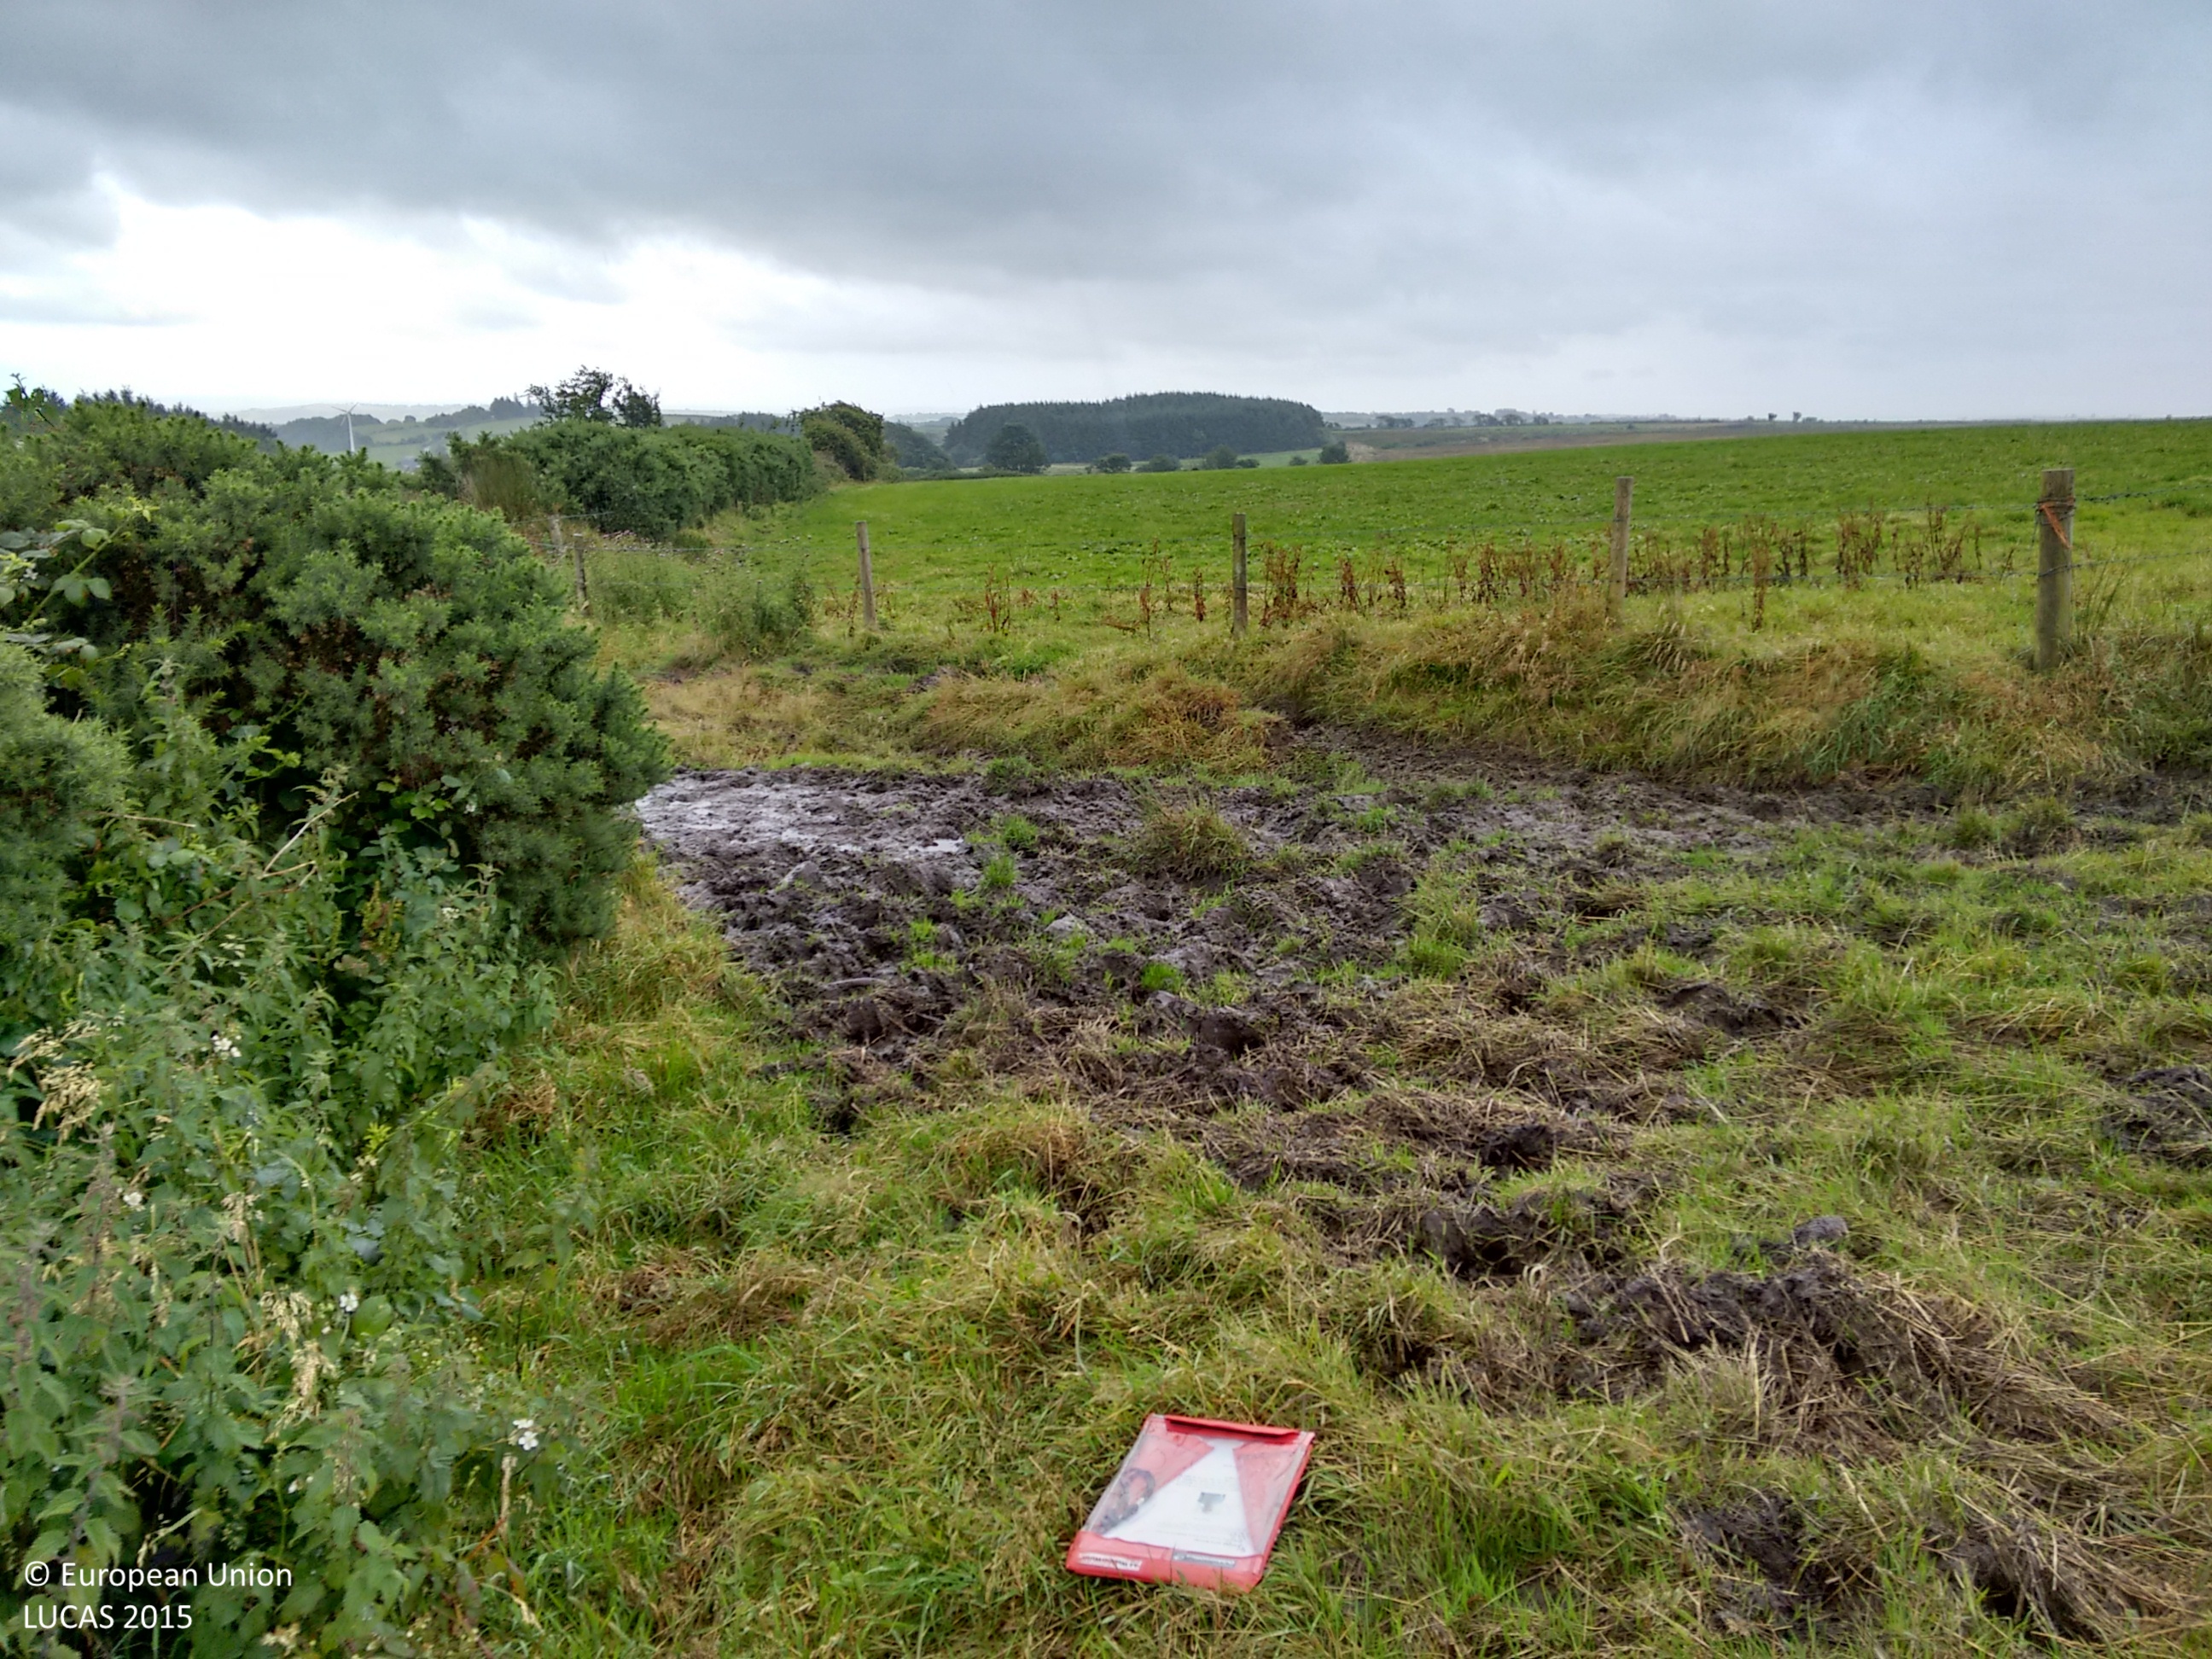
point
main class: Grassland
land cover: Grassland without tree/shrub cover
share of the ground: > 75 %
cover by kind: herbaceous plants 80 %, unconsolidated bare surface 20 %
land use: Agriculture (excluding fallow land and kitchen gardens)
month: August
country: GB
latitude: 51.9670
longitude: -4.4112
